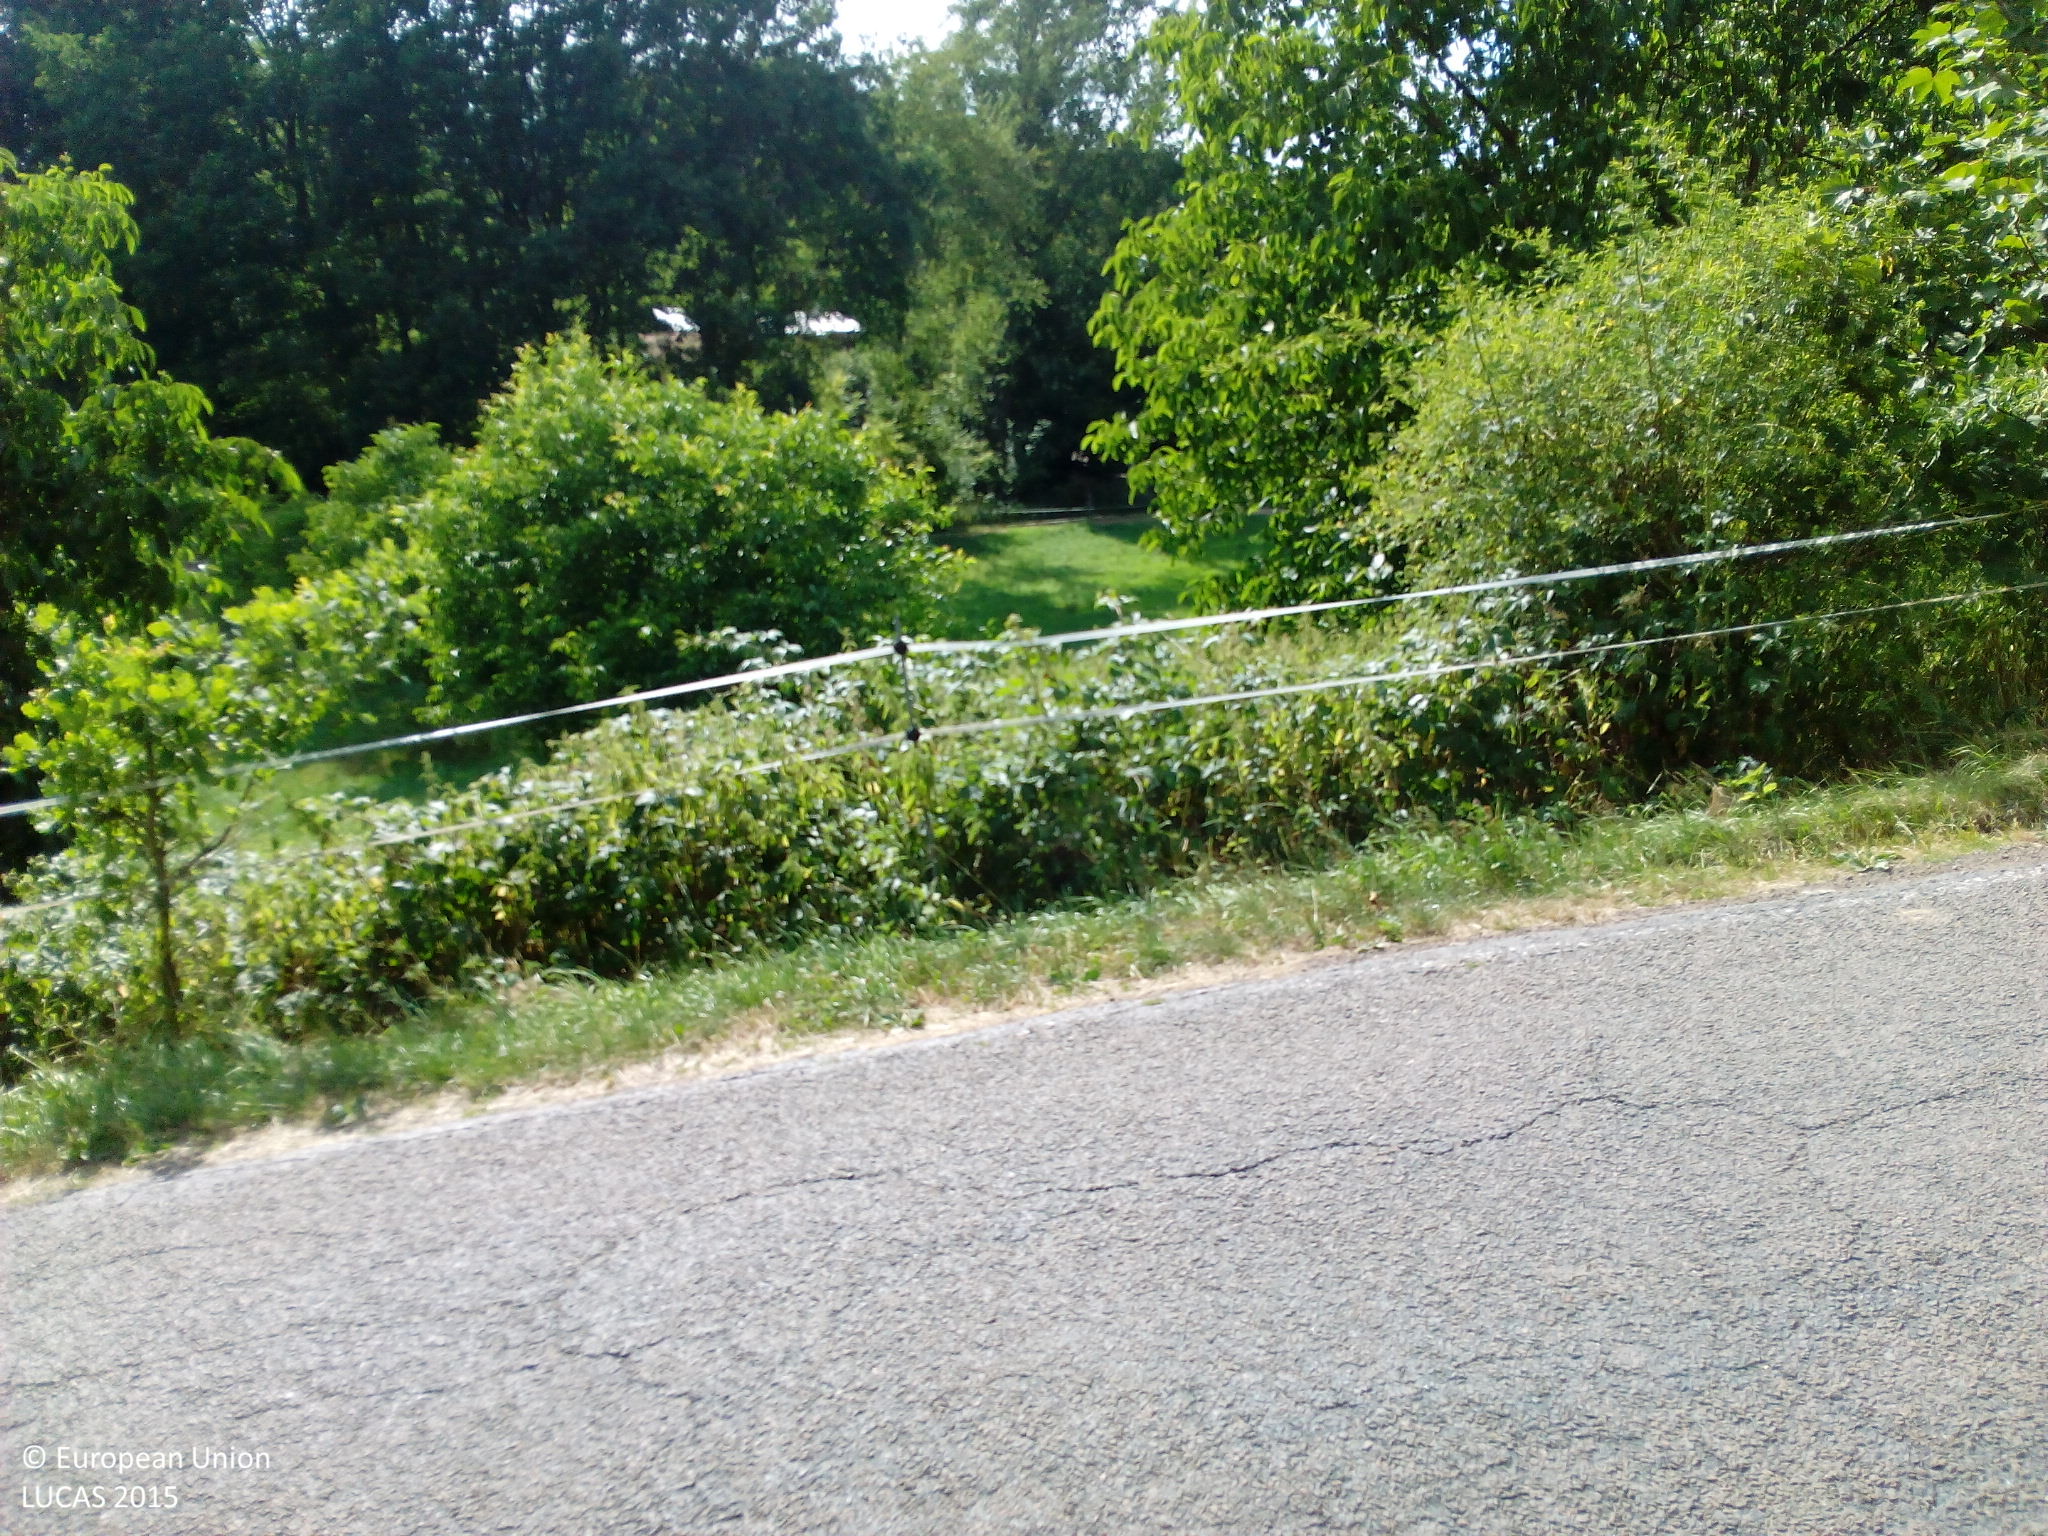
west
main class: Cropland
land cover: Cherry fruit
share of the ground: > 75 %
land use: Kitchen garden
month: July
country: DE
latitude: 49.5366
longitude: 7.1399
